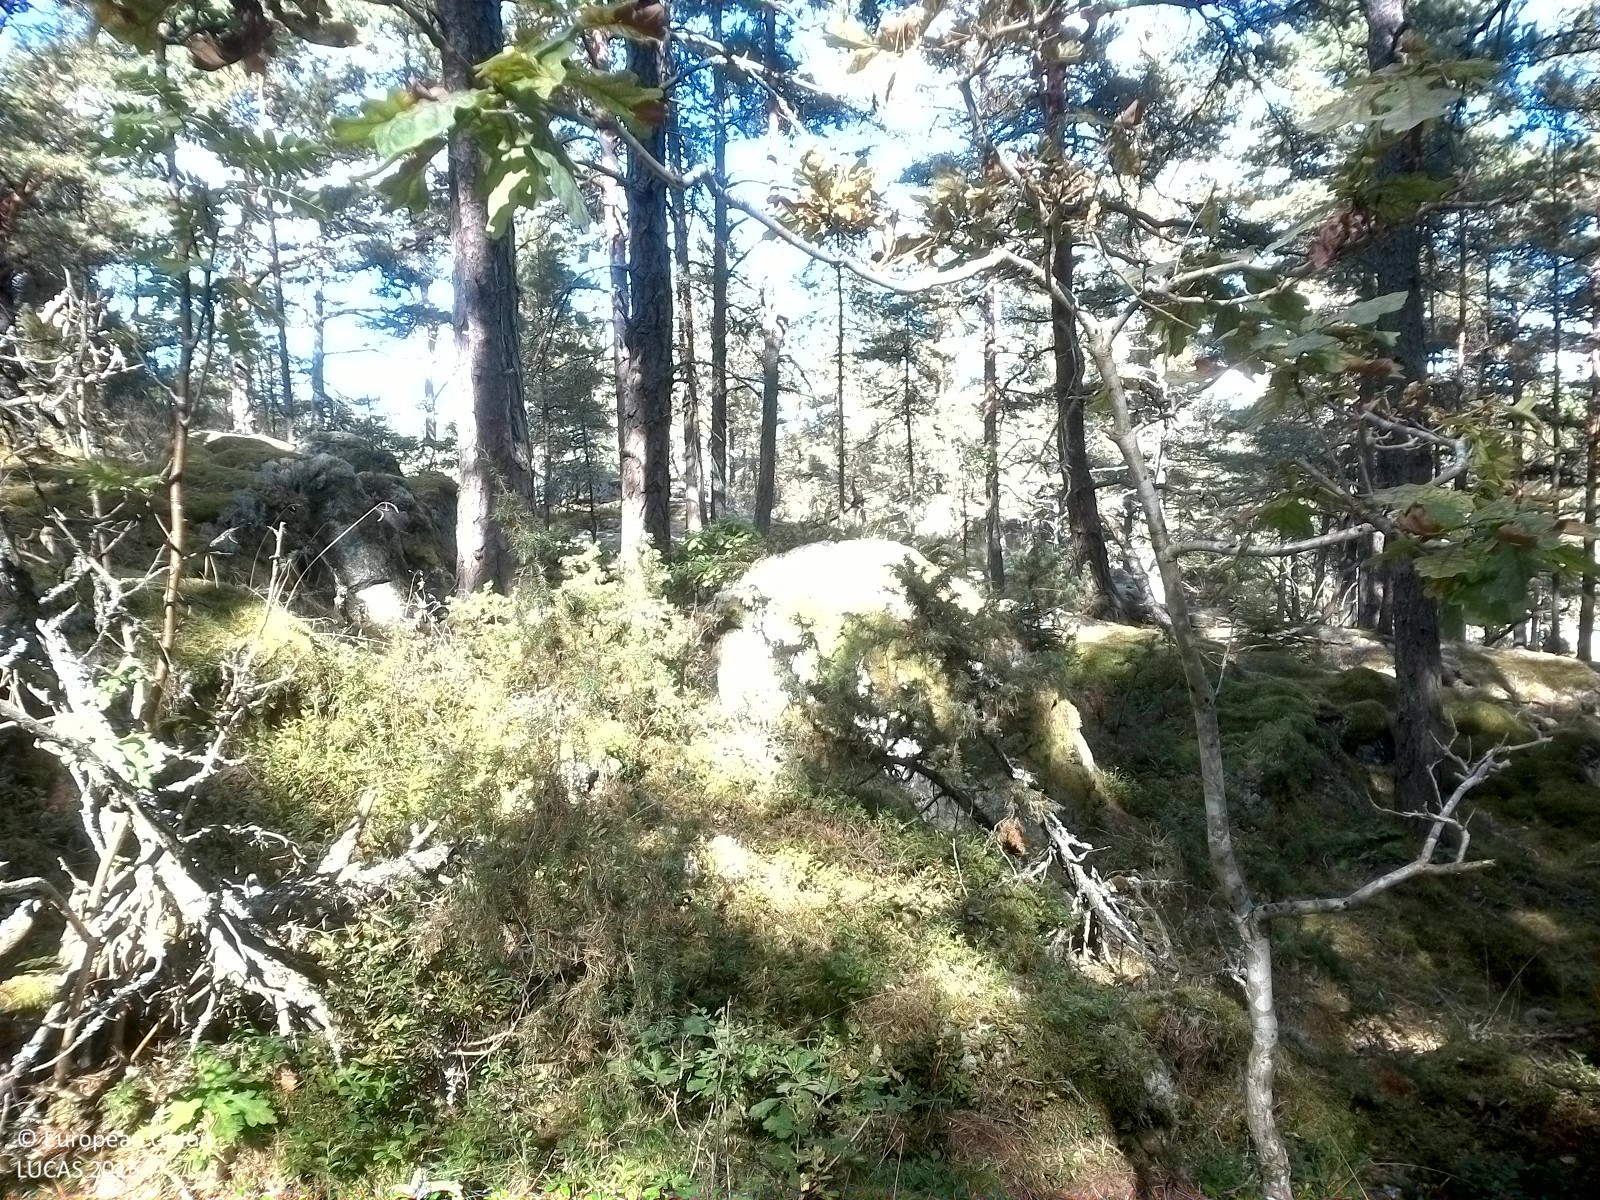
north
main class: Woodland
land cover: Pine dominated coniferous woodland
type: boreal forest
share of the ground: 25 - 50 %
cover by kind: herbaceous plants 55 %, coniferous forest trees 25 %, lichens and mosses 15 %, broadleaved forest trees 5 %
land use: Forestry
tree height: > 5 m
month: September
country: SE
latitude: 58.5232
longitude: 16.2971
